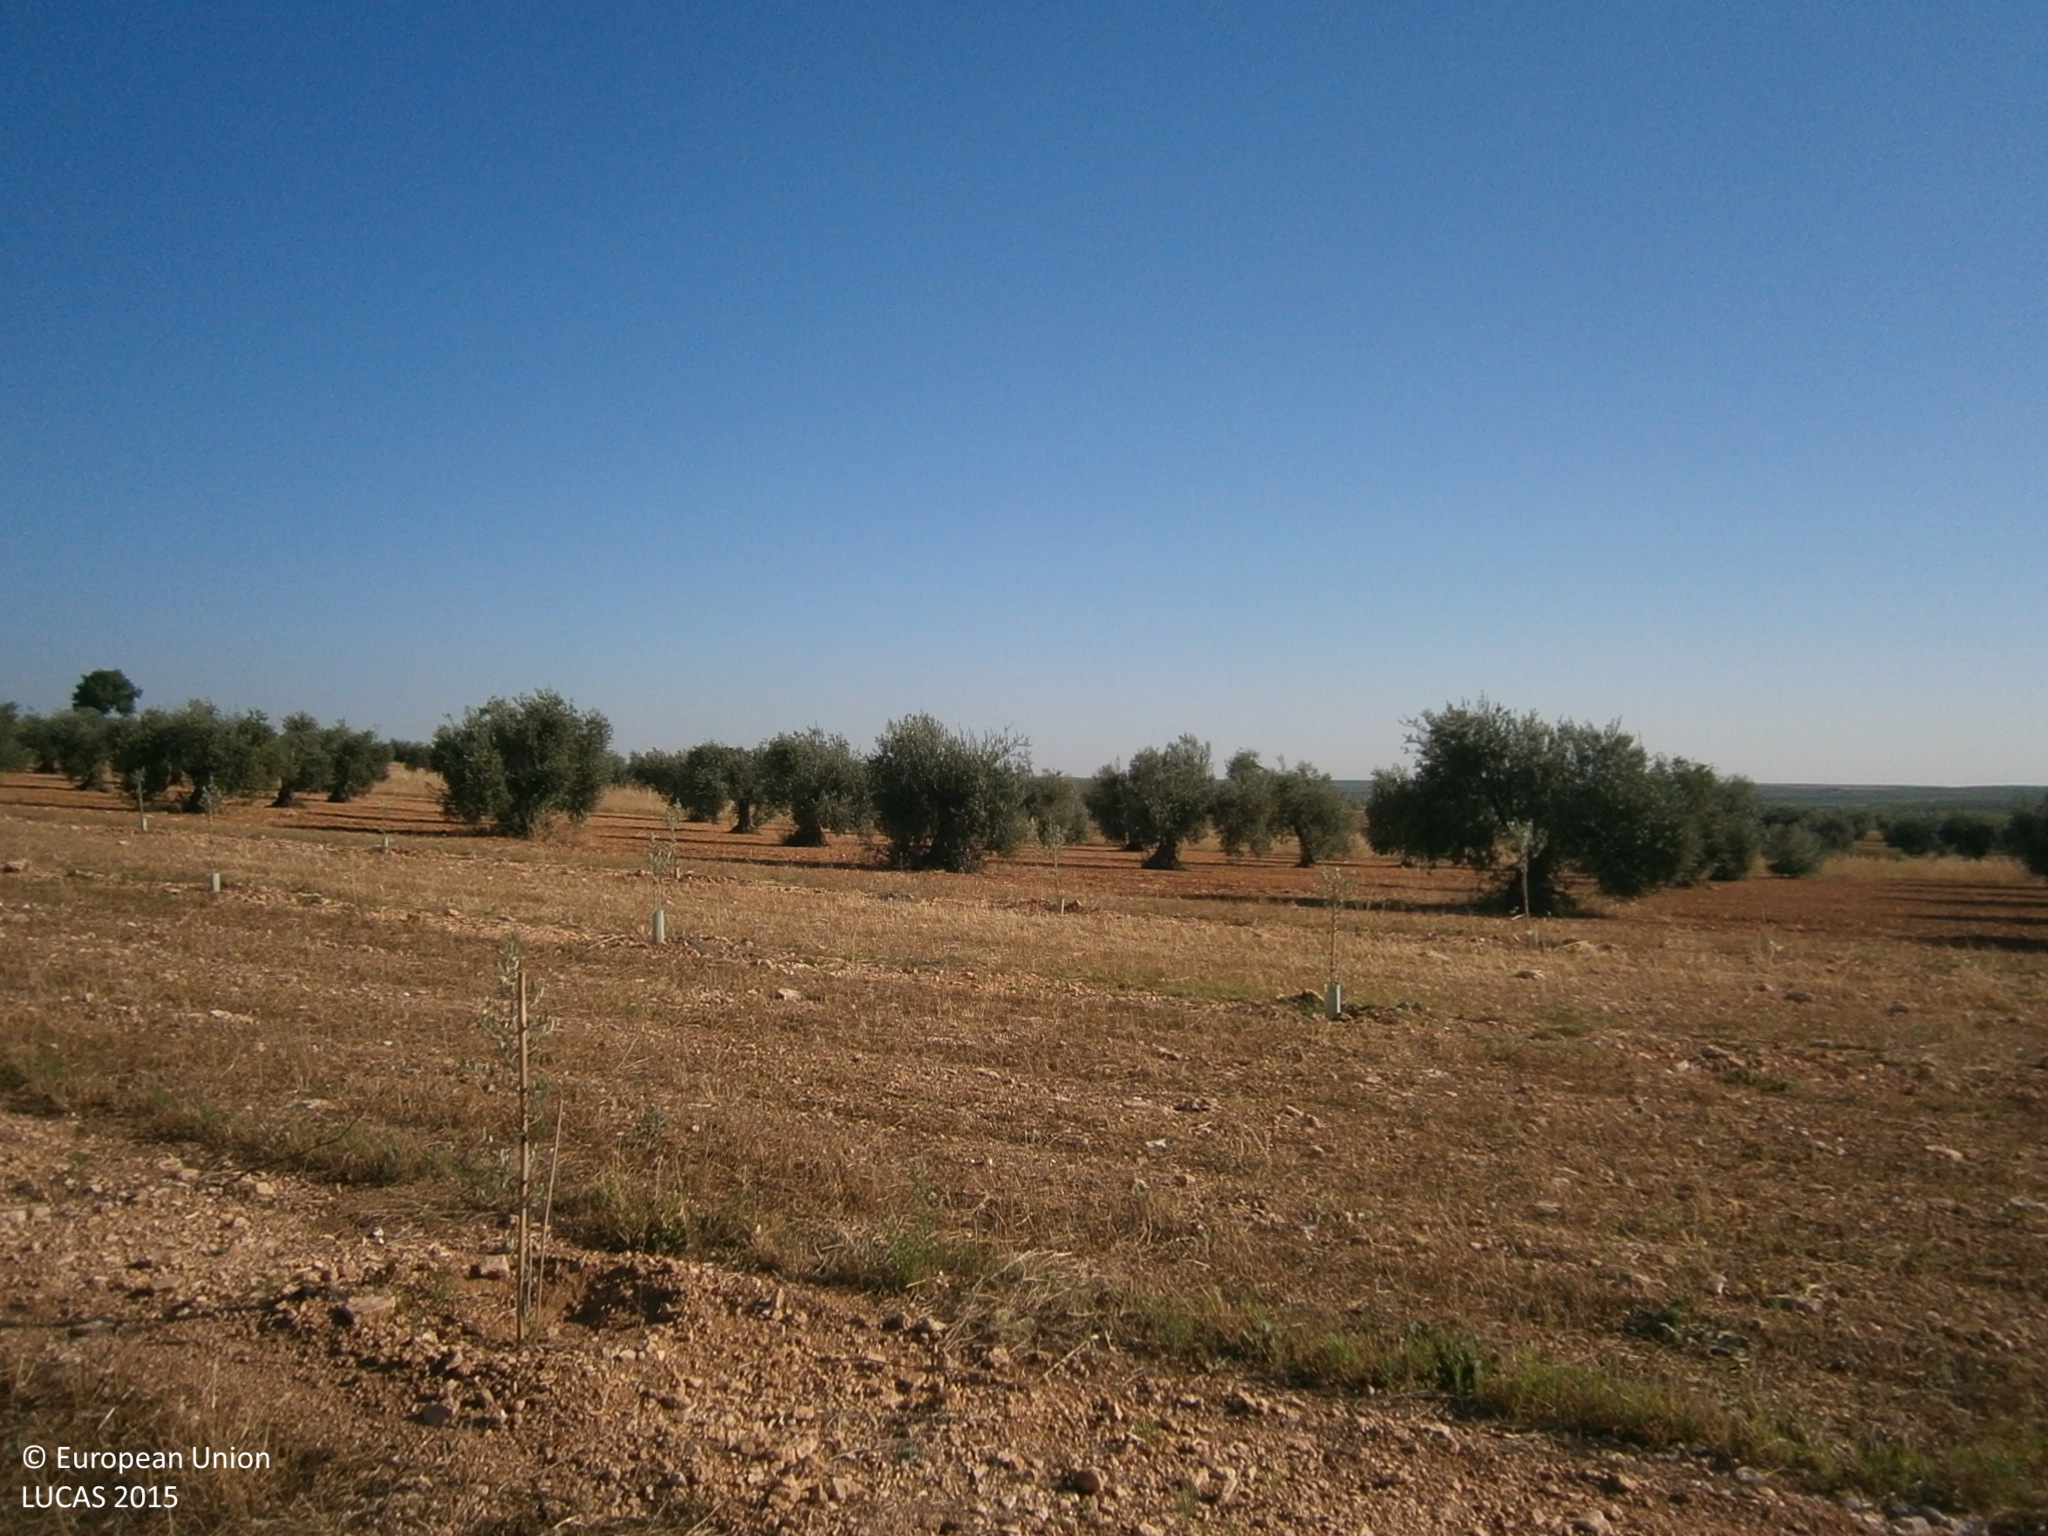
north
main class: Cropland
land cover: Olive groves
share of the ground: < 10 %
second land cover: Spontaneously vegetated surfaces
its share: > 75 %
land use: Agriculture (excluding fallow land and kitchen gardens)
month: June
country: ES
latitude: 38.6998
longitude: -6.6754
